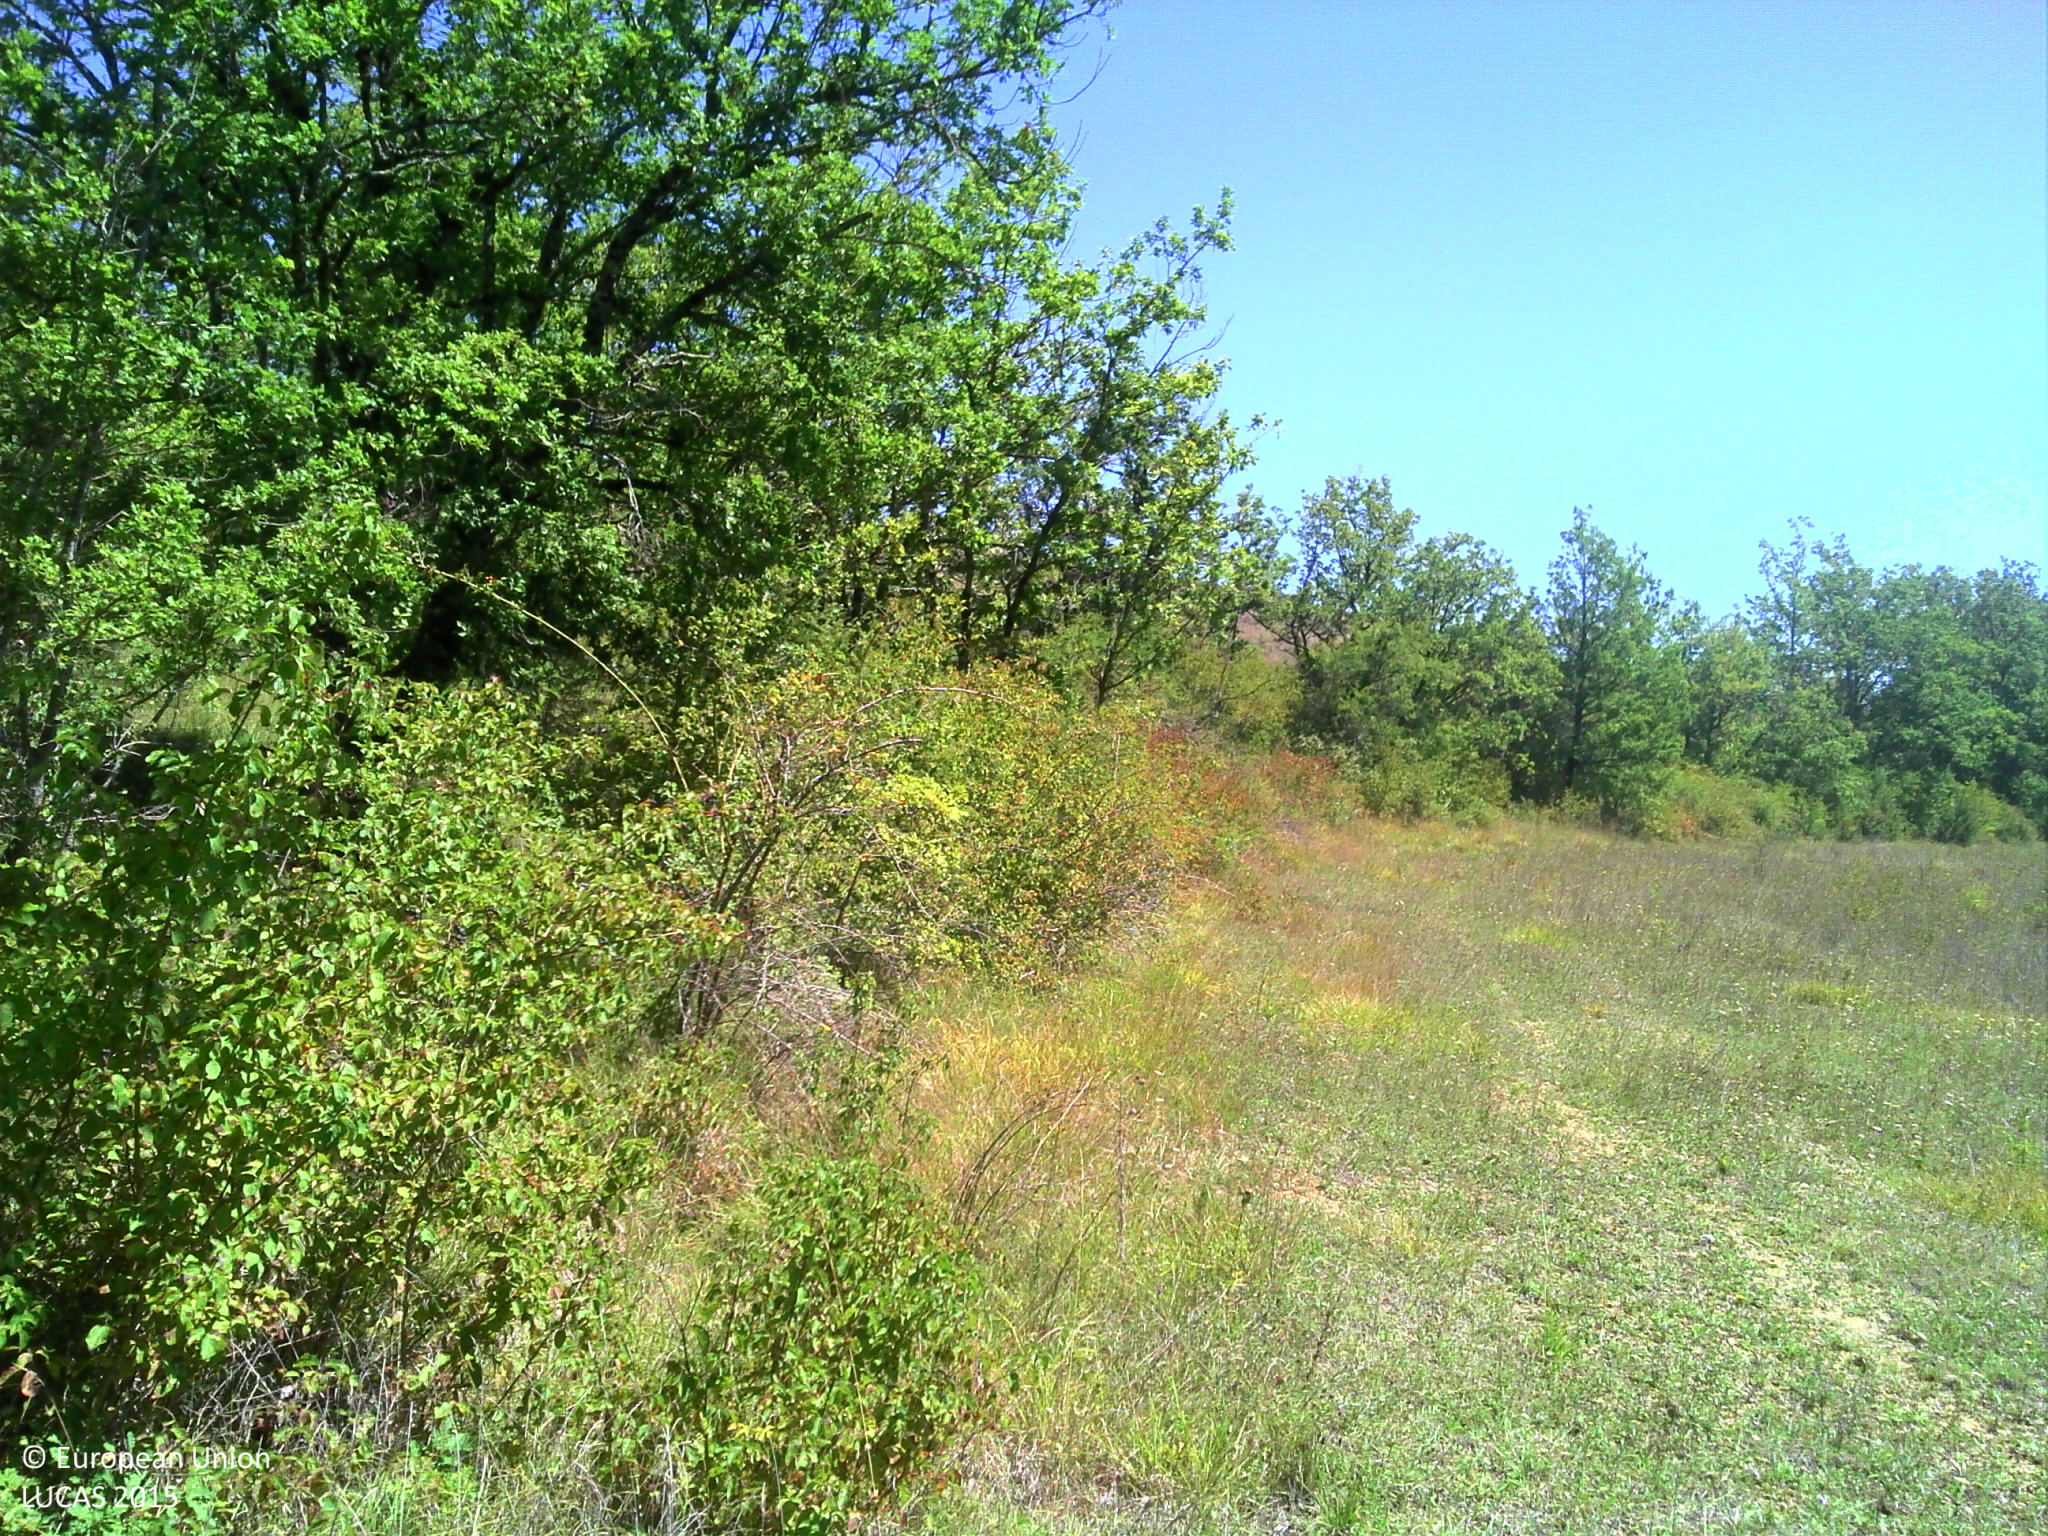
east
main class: Grassland
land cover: Grassland without tree/shrub cover
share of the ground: > 75 %
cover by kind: herbaceous plants 100 %
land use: Agriculture (excluding fallow land and kitchen gardens)
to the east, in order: Grassland without tree/shrub cover; Broadleaved woodland; Grassland with sparse tree/shrub cover; Other bare soil
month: August
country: FR
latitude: 44.2767
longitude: 1.5423
